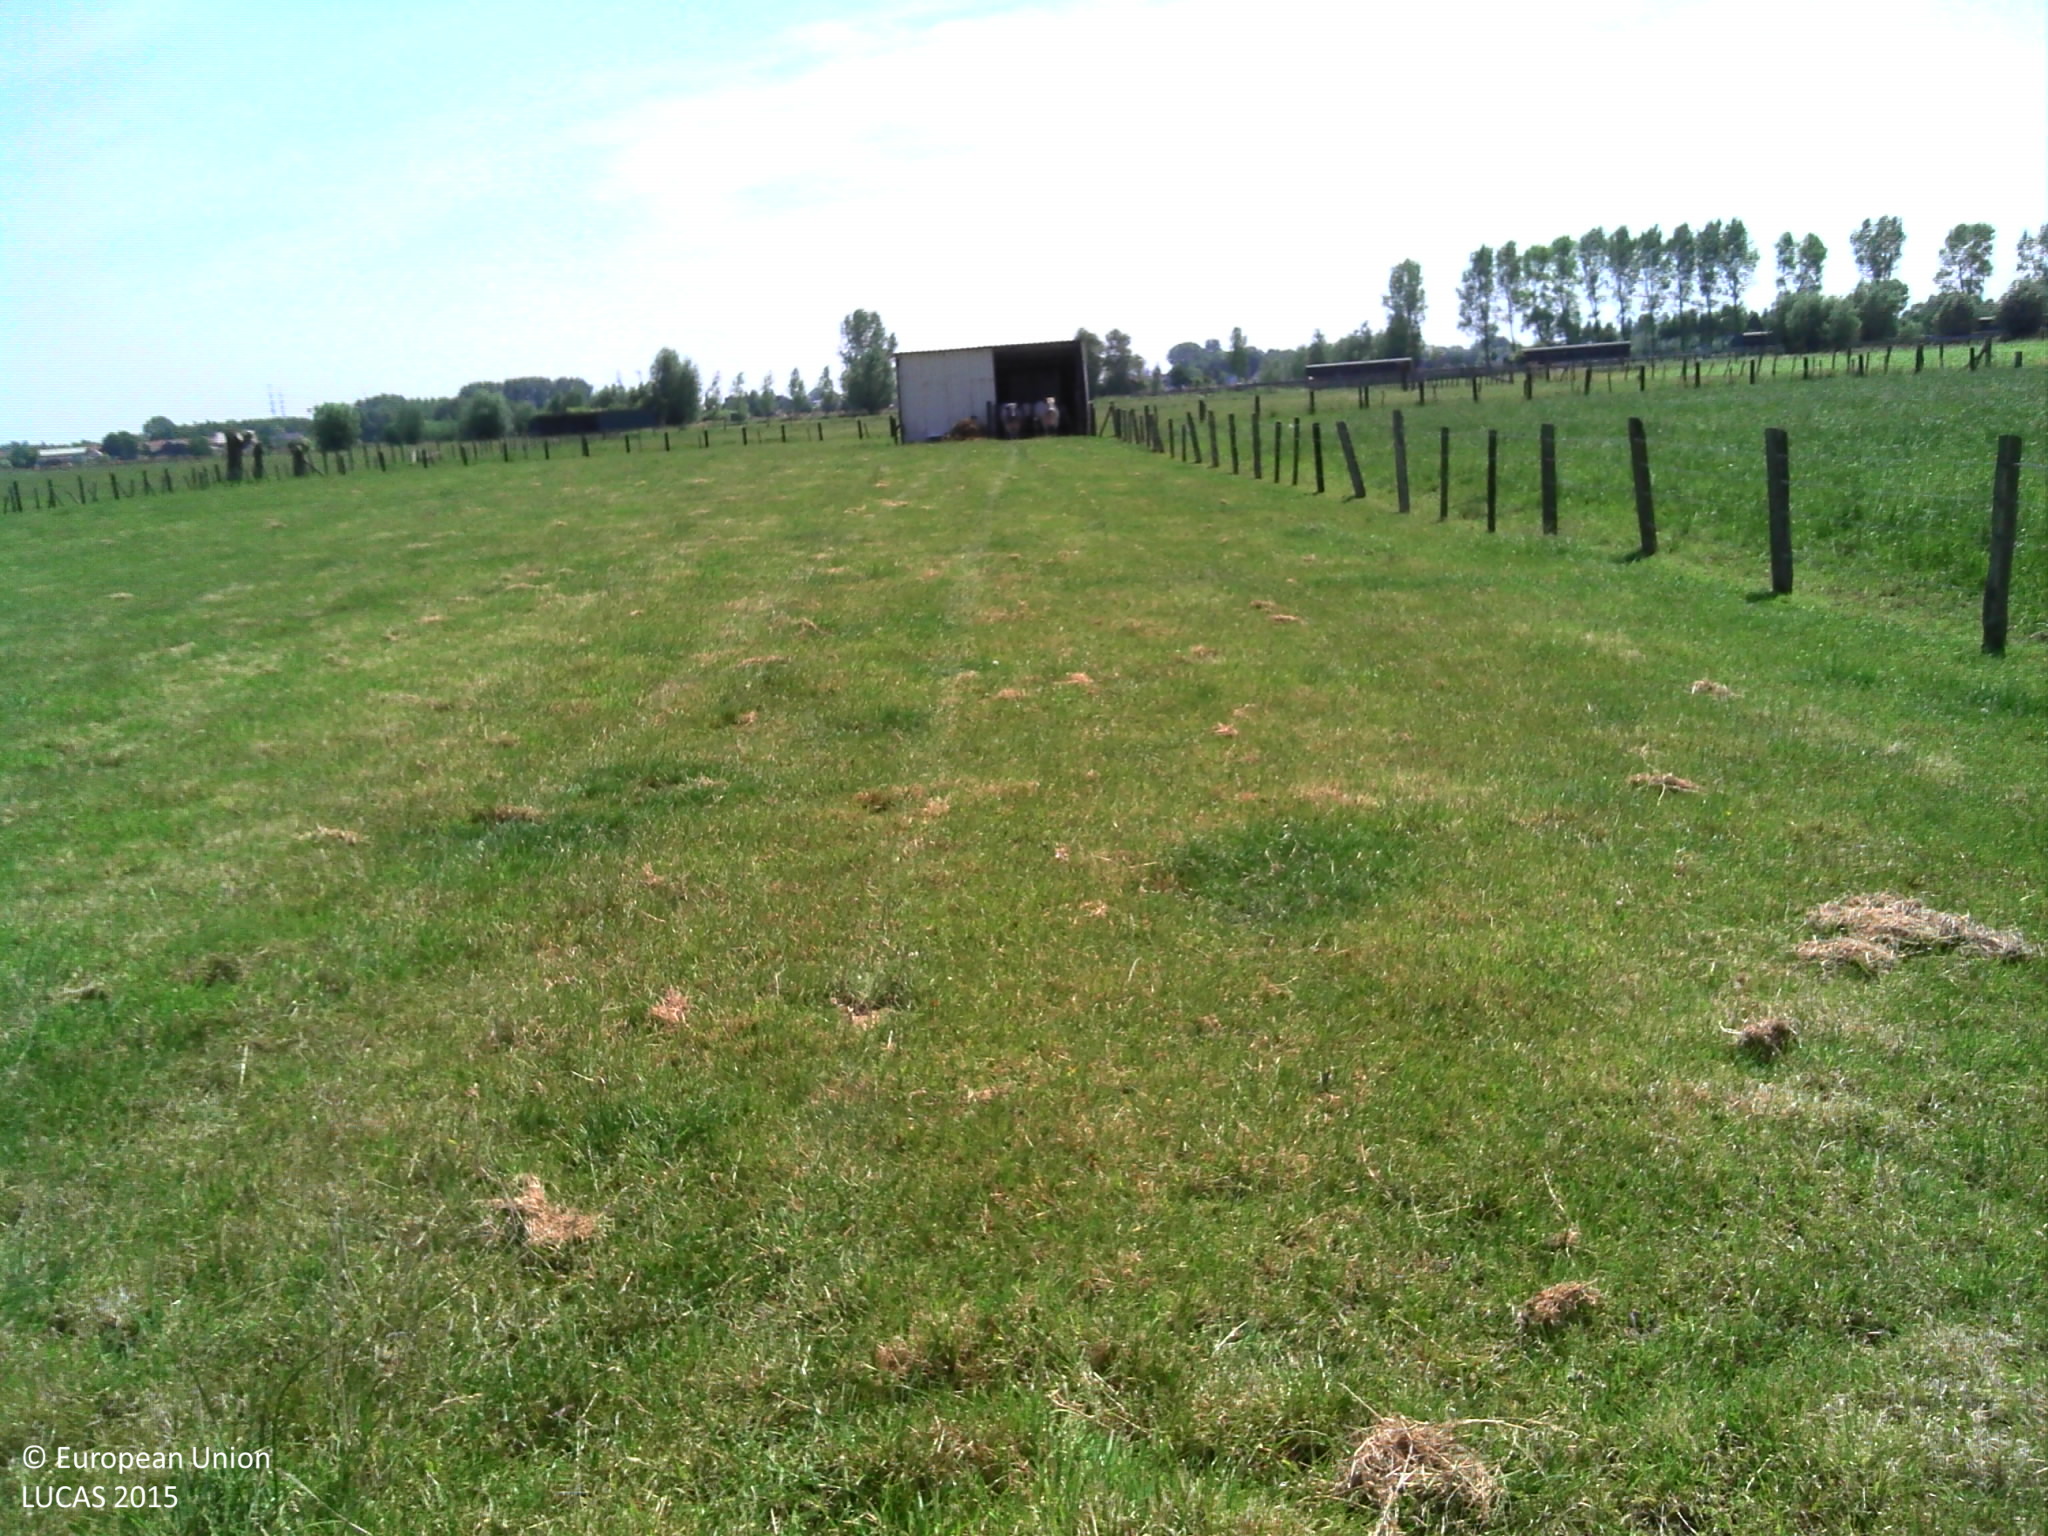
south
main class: Grassland
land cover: Grassland without tree/shrub cover
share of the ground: > 75 %
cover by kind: herbaceous plants 100 %
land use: Agriculture (excluding fallow land and kitchen gardens)
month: June
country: BE
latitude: 51.0921
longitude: 4.0403
